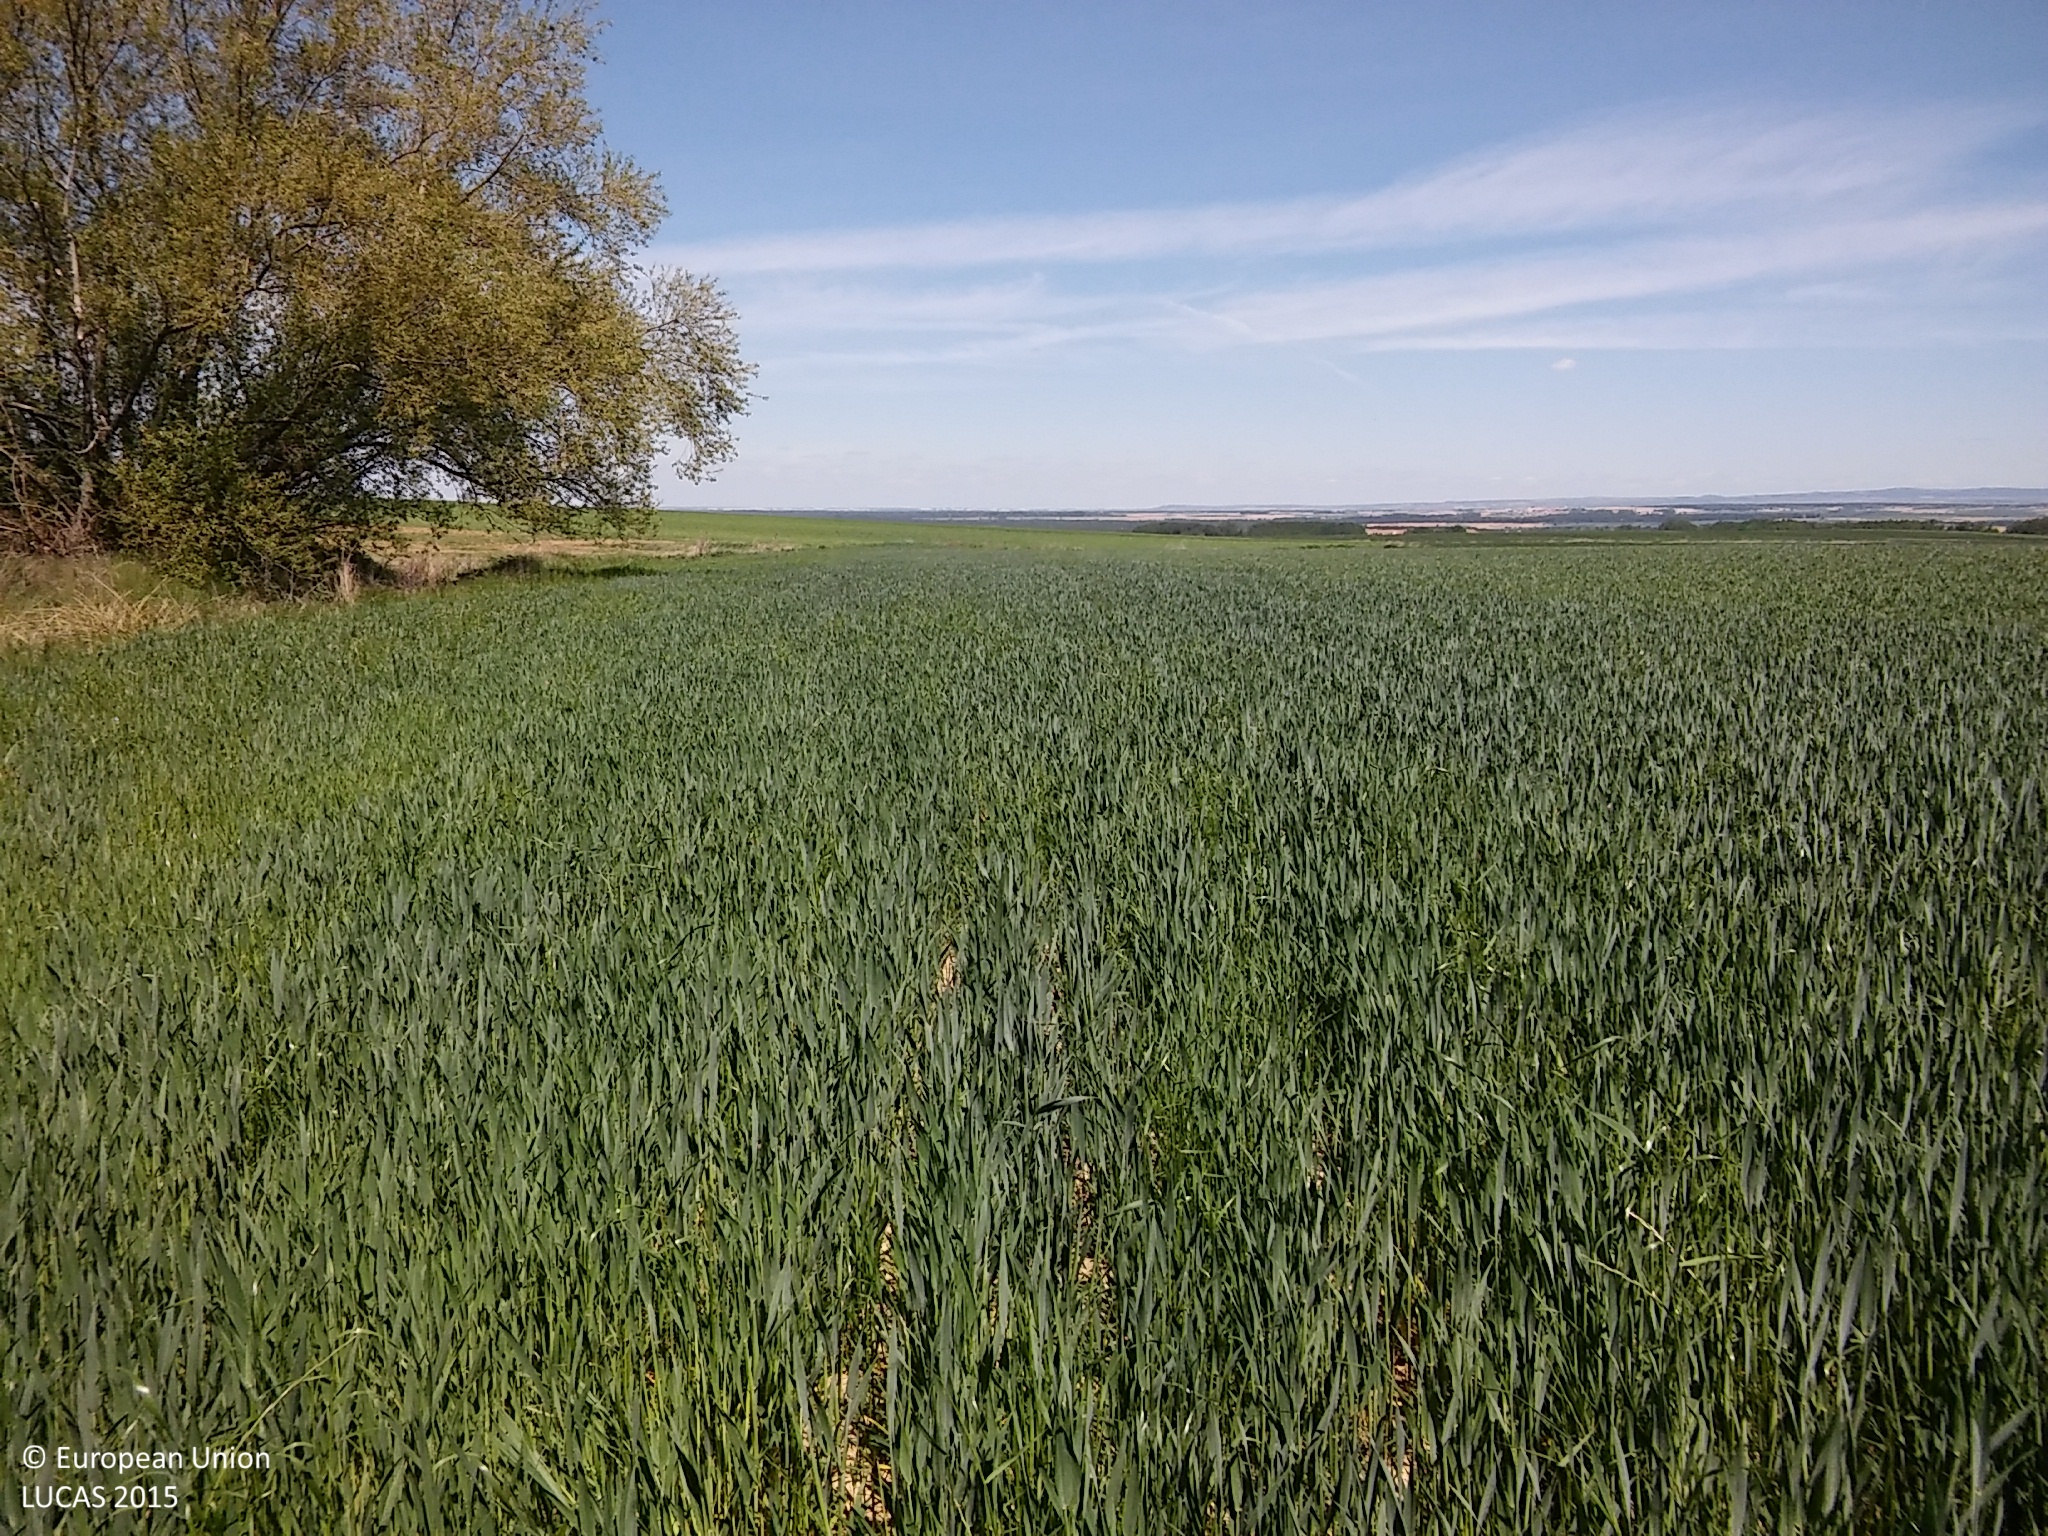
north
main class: Cropland
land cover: Common wheat
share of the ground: > 75 %
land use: Agriculture (excluding fallow land and kitchen gardens)
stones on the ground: < 10 %
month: May
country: ES
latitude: 41.1516
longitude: -3.9562
